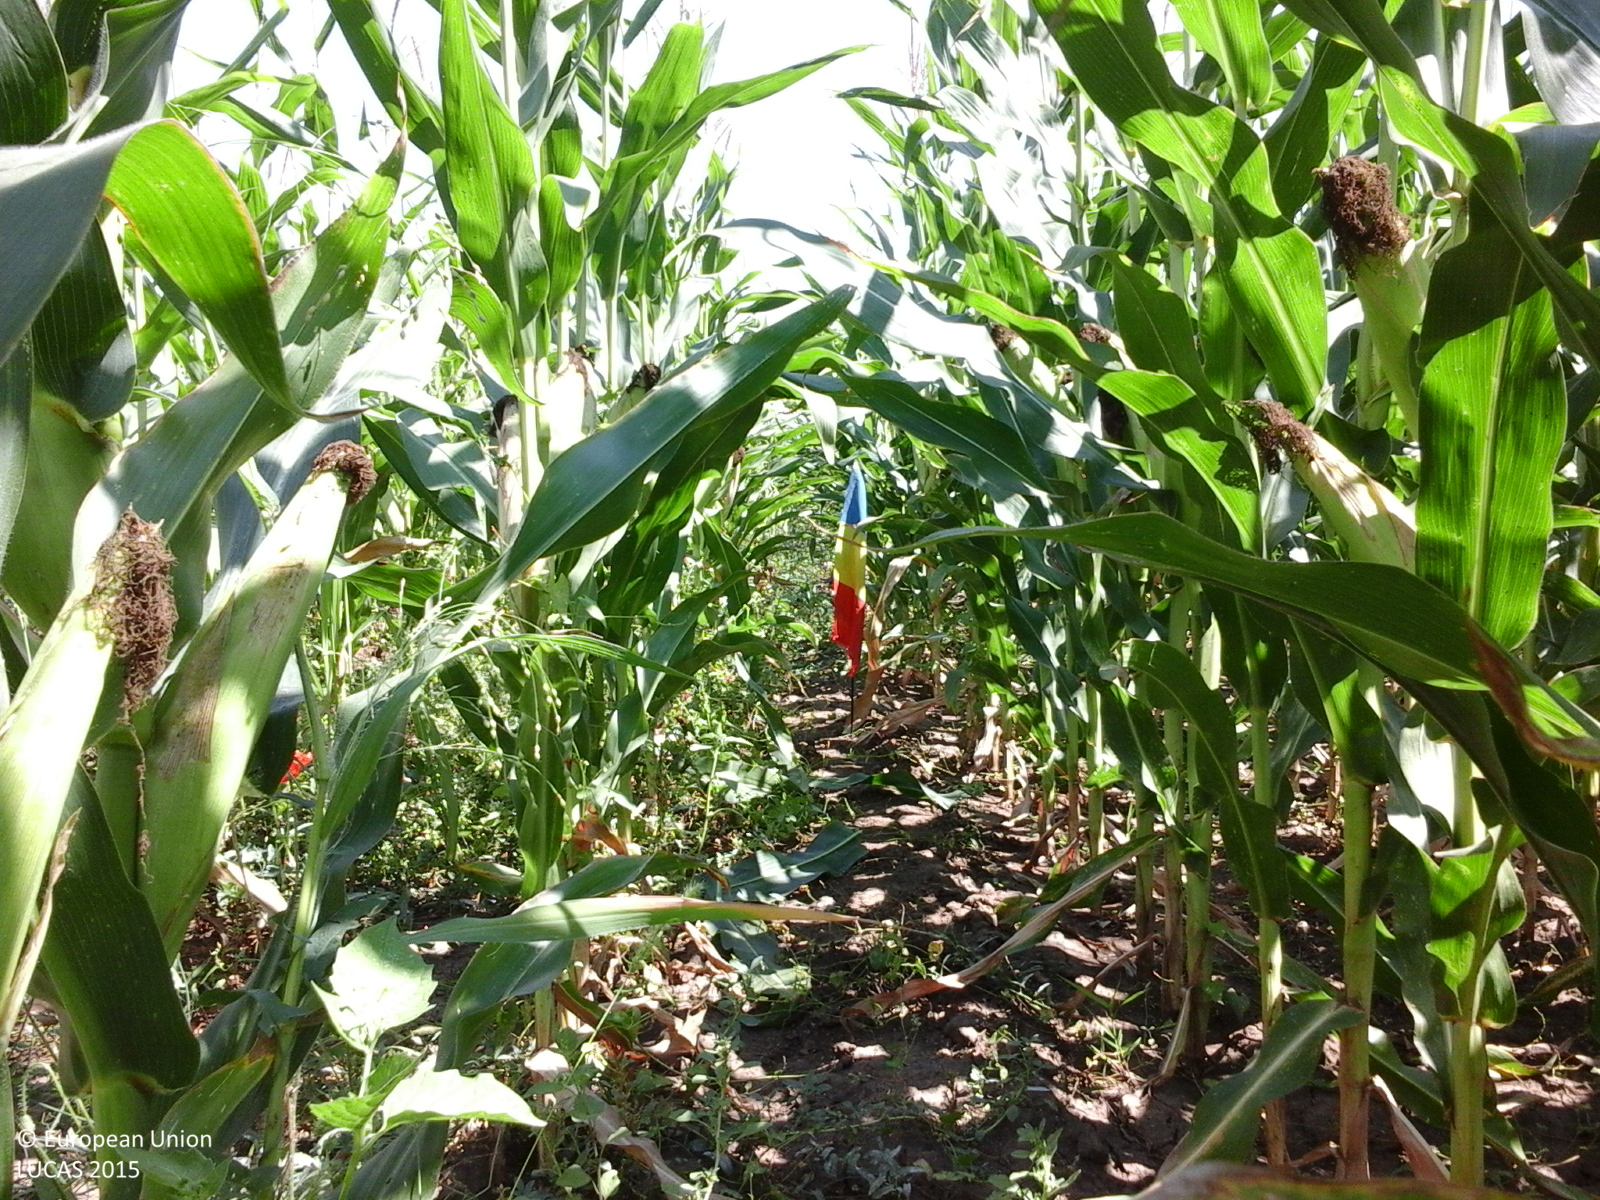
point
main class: Cropland
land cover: Maize
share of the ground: > 75 %
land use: Agriculture (excluding fallow land and kitchen gardens)
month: August
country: RO
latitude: 44.3499
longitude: 28.3962
